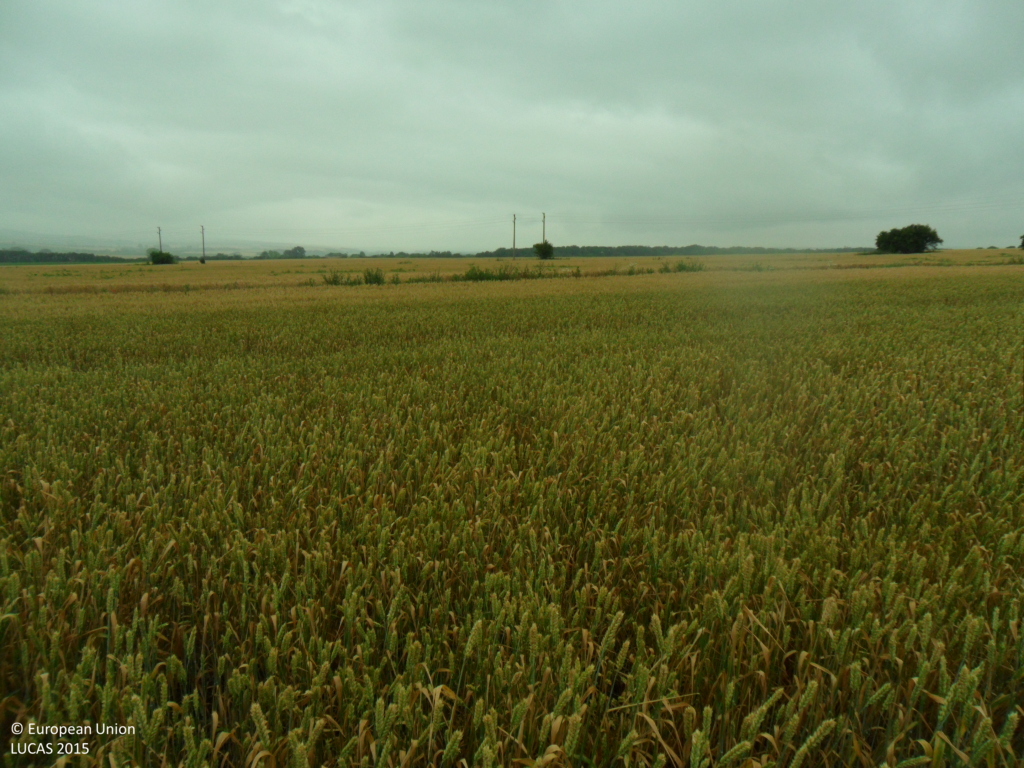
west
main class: Cropland
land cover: Common wheat
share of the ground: > 75 %
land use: Agriculture (excluding fallow land and kitchen gardens)
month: June
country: BG
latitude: 43.3222
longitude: 26.9968
